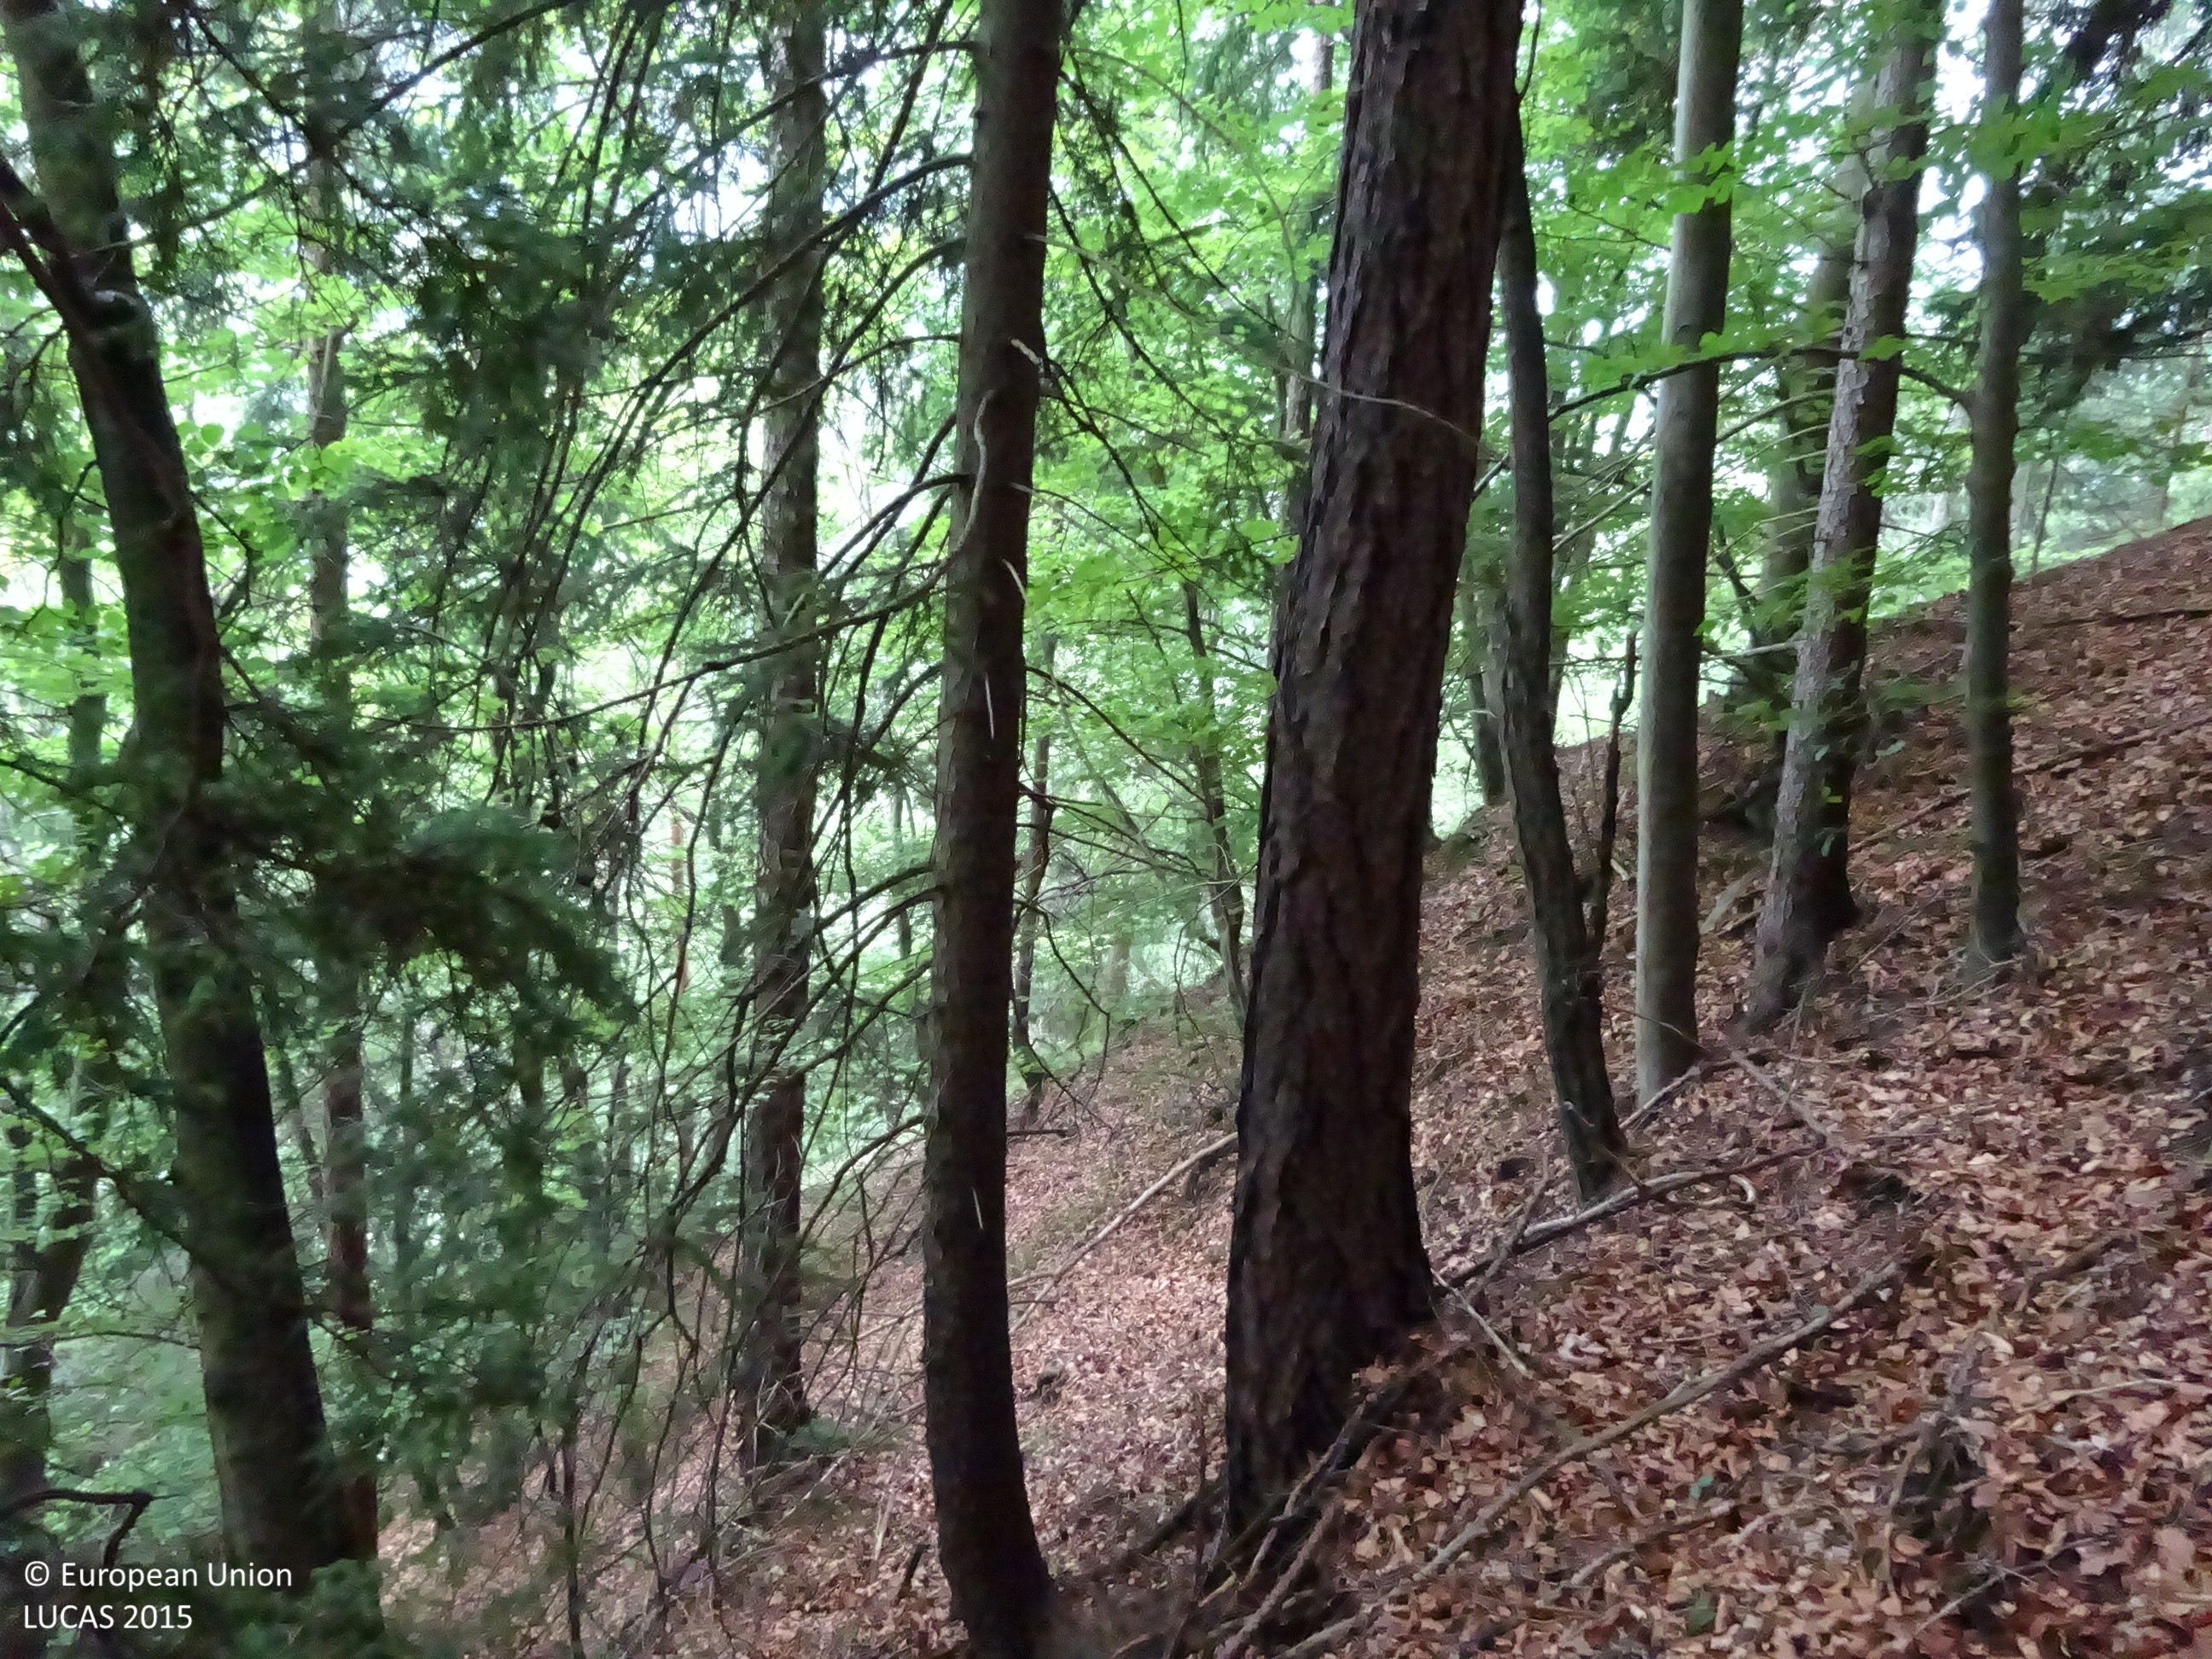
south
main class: Woodland
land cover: Broadleaved woodland
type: mountainous beech forest
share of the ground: > 75 %
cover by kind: broadleaved forest trees 80 %, coniferous forest trees 20 %
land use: Forestry
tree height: > 5 m
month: July
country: AT
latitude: 47.2818
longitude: 15.3545
